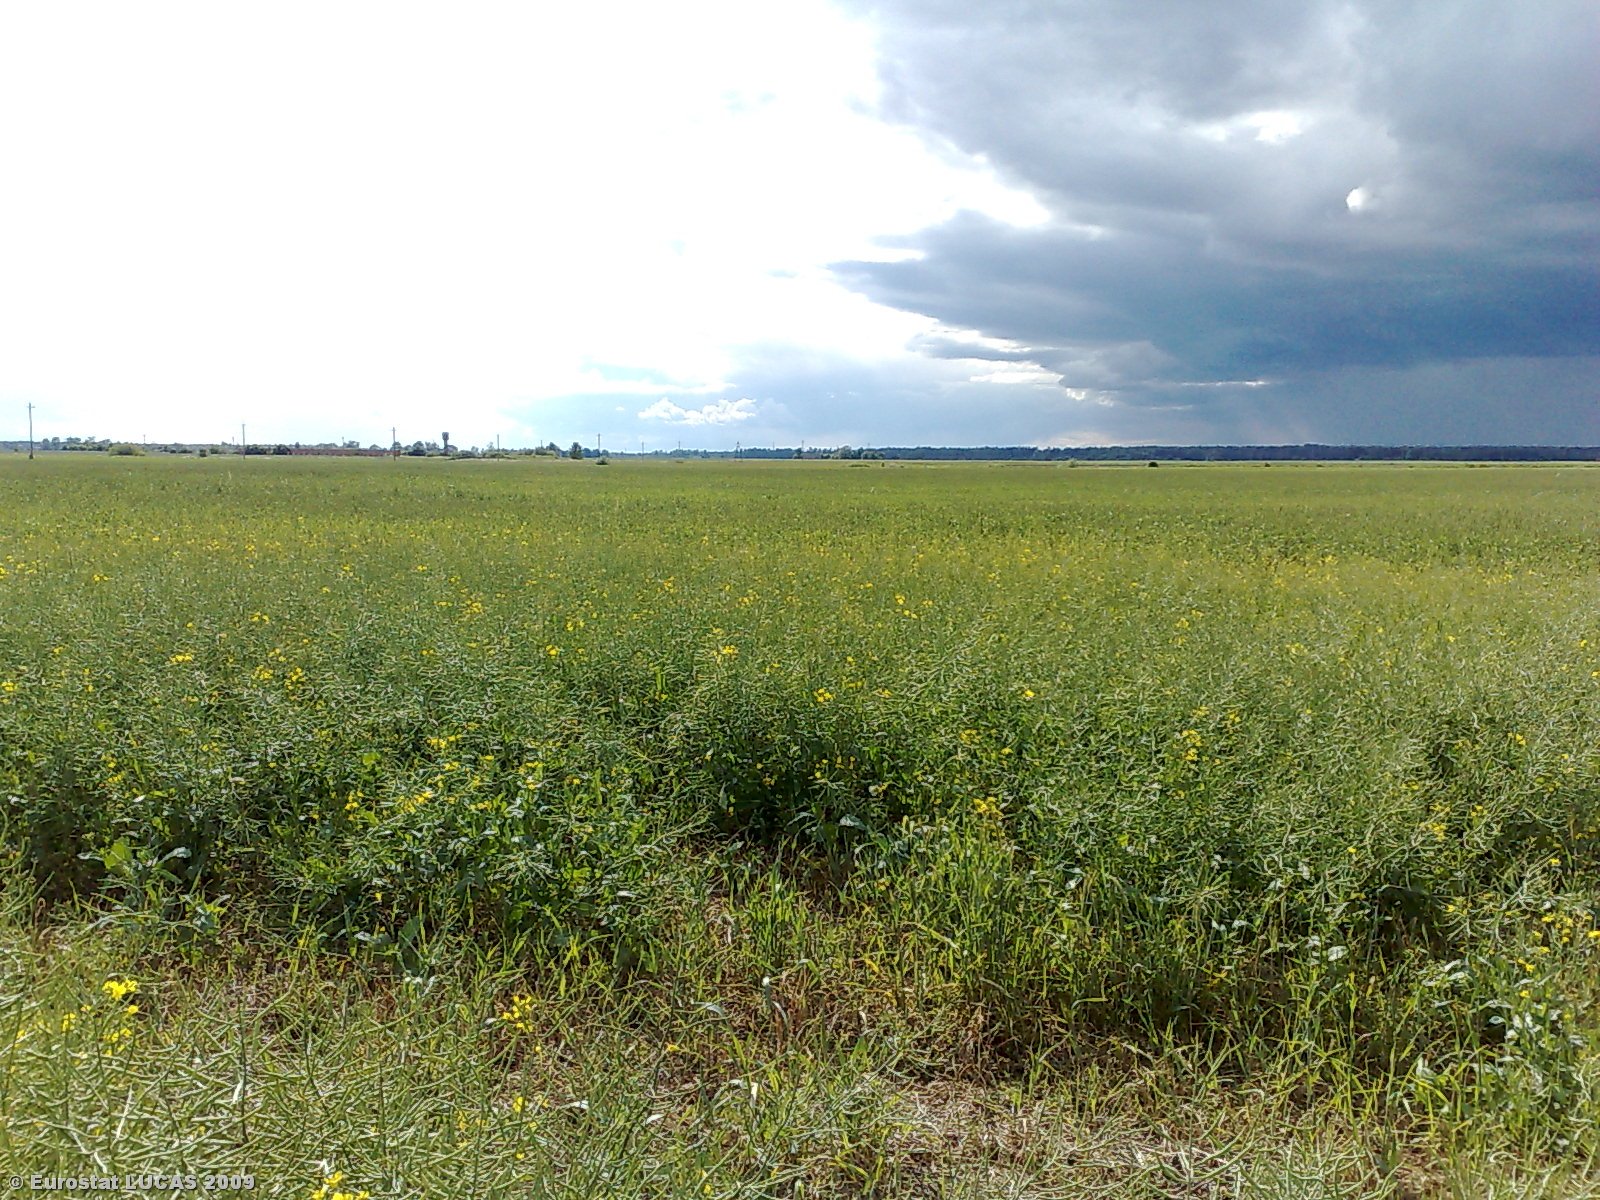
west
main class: Cropland
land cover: Rape and turnip rape
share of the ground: > 75 %
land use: Agriculture (excluding fallow land and kitchen gardens)
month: June
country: LT
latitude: 56.0116
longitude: 23.8951
